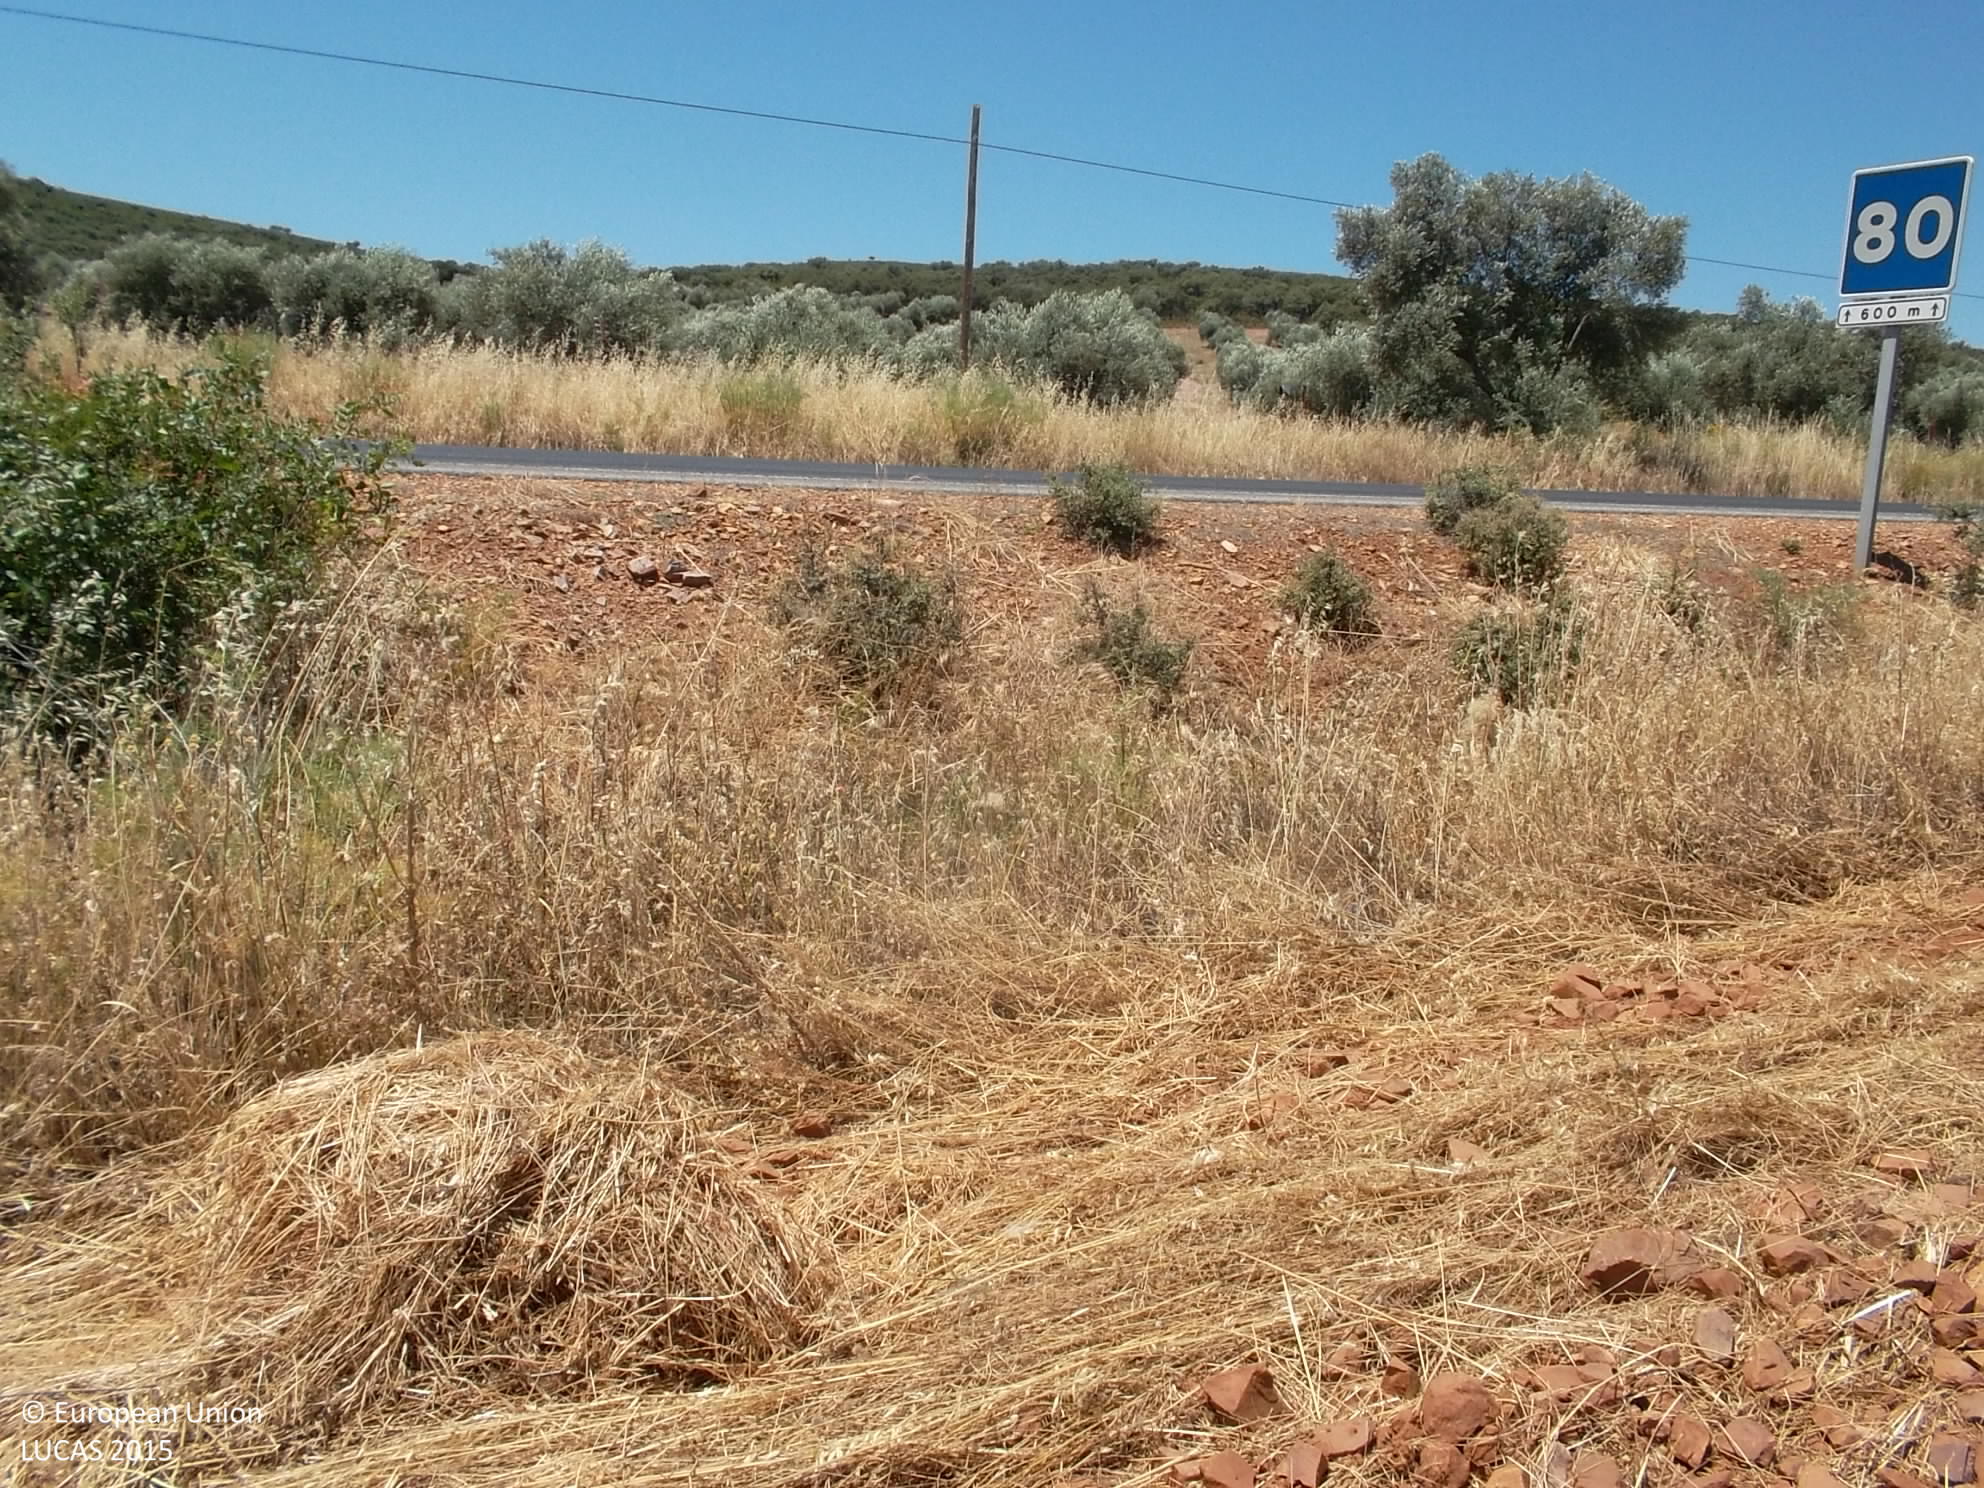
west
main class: Cropland
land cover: Common wheat
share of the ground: > 75 %
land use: Agriculture (excluding fallow land and kitchen gardens)
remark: Harvested field
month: June
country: ES
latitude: 39.0973
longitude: -4.0959
